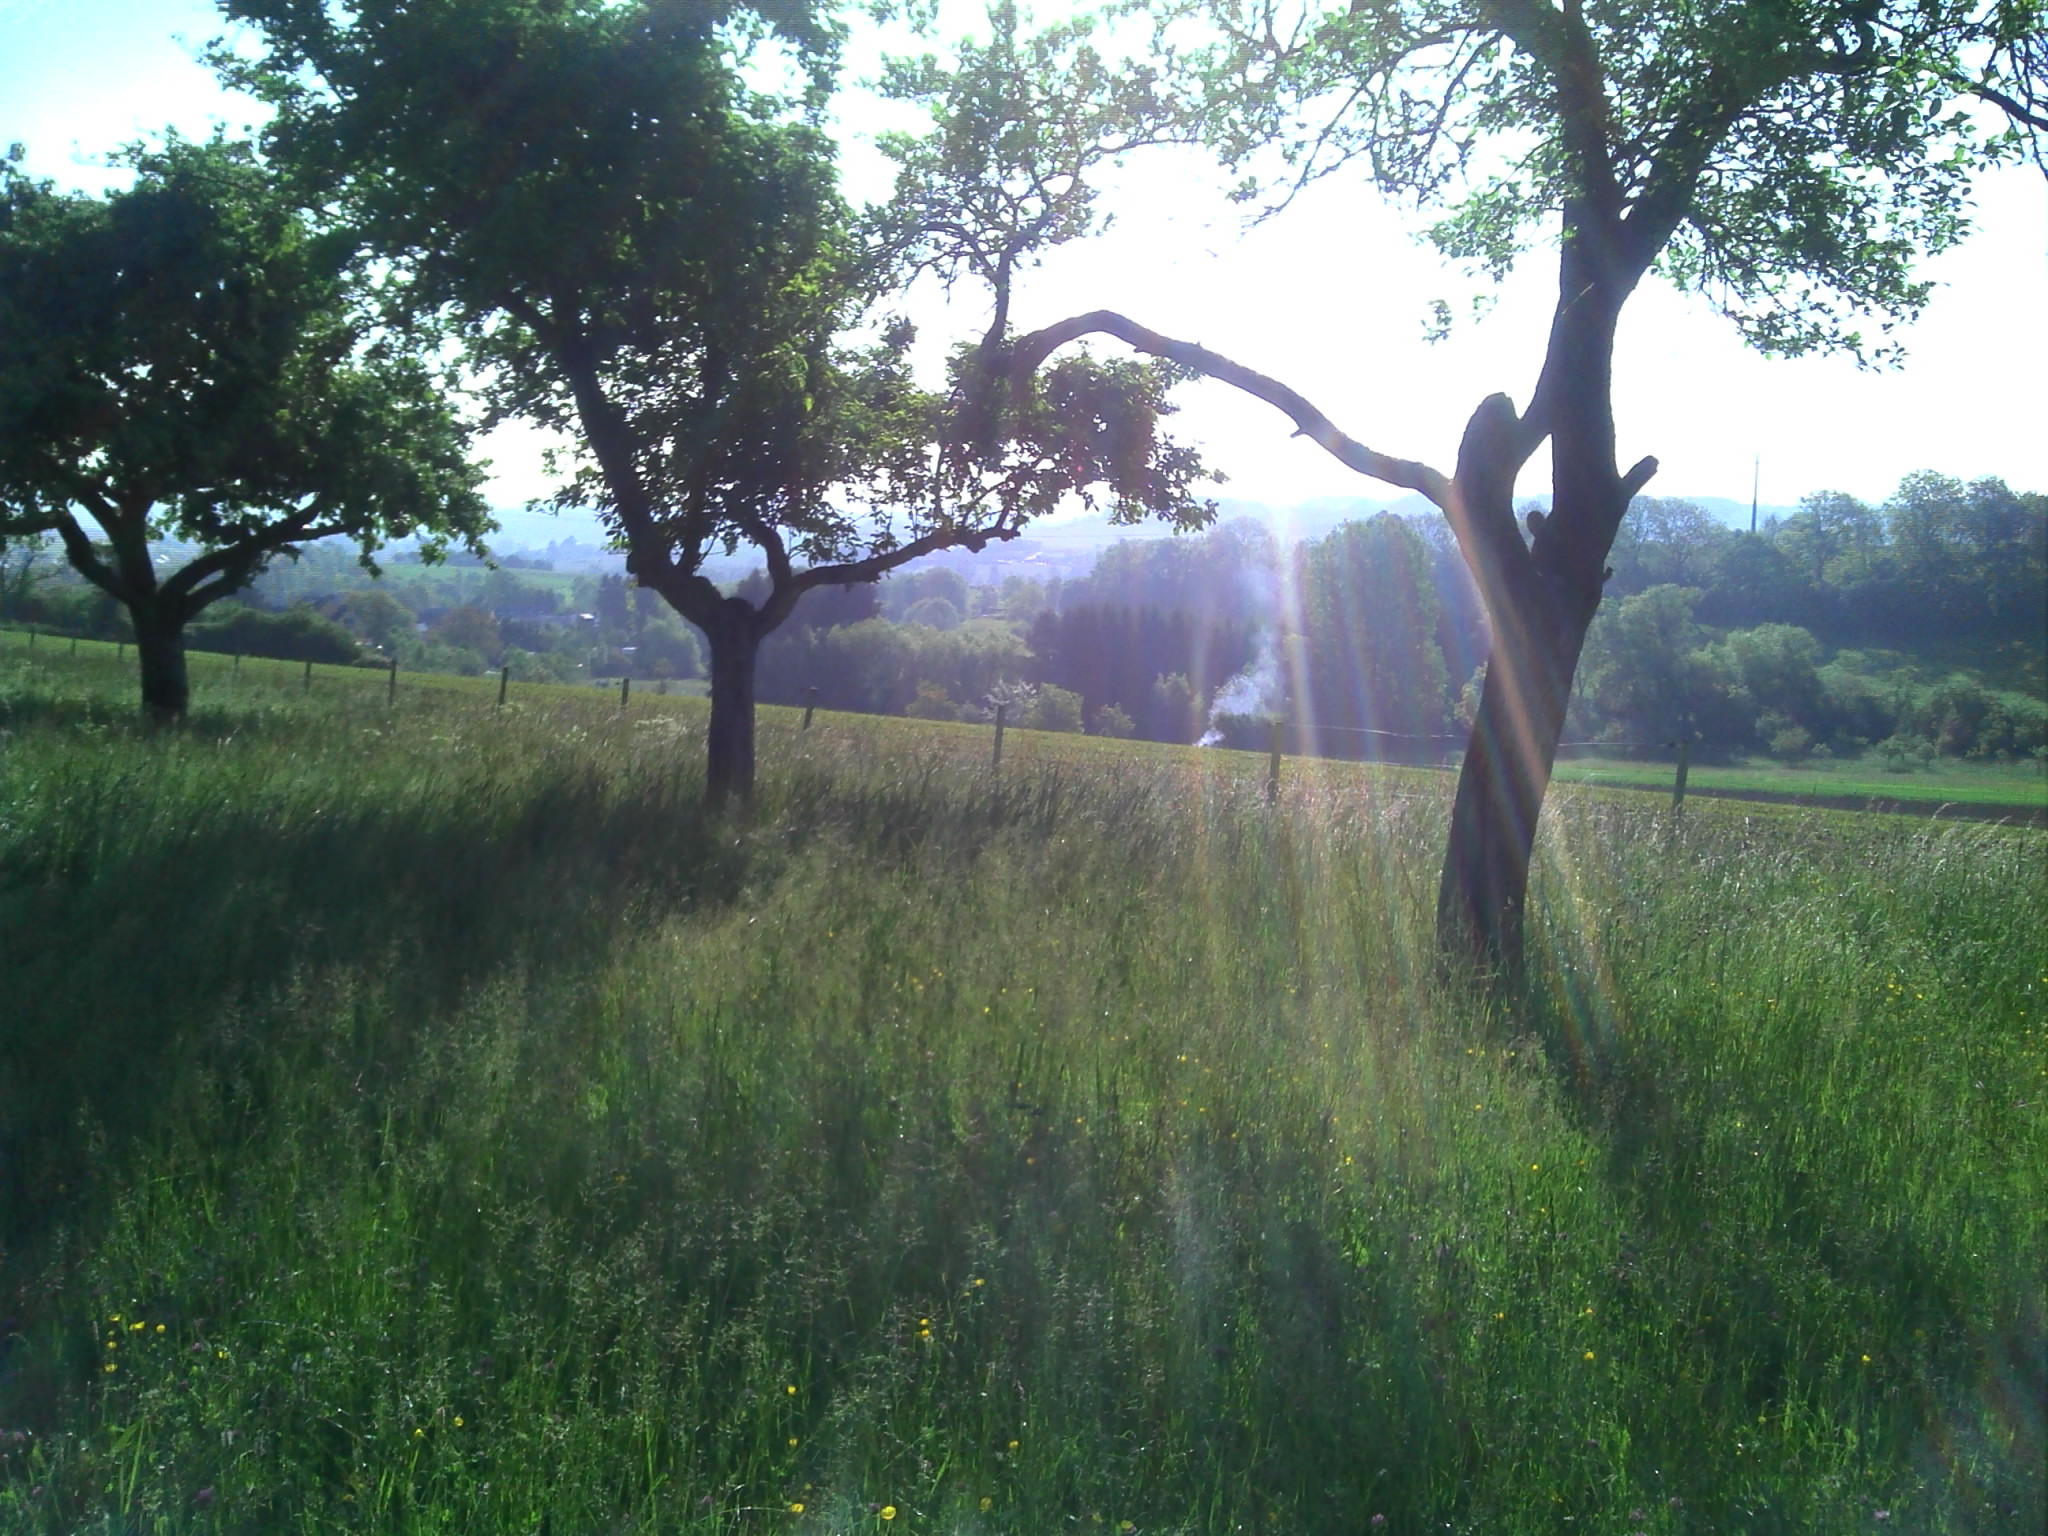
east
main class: Grassland
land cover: Grassland with sparse tree/shrub cover
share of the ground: > 75 %
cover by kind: herbaceous plants 95 %, broadleaved forest trees 5 %
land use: Agriculture (excluding fallow land and kitchen gardens)
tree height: > 5 m
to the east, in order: Grassland with sparse tree/shrub cover; Fences; Maize; Paved roads, cycling and walking lanes; Grass margins; Fences; Grassland without tree/shrub cover; Managed hedges; Other fresh vegetables; Grassland with sparse tree/shrub cover
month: May
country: LU
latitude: 49.5485
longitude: 6.3093
